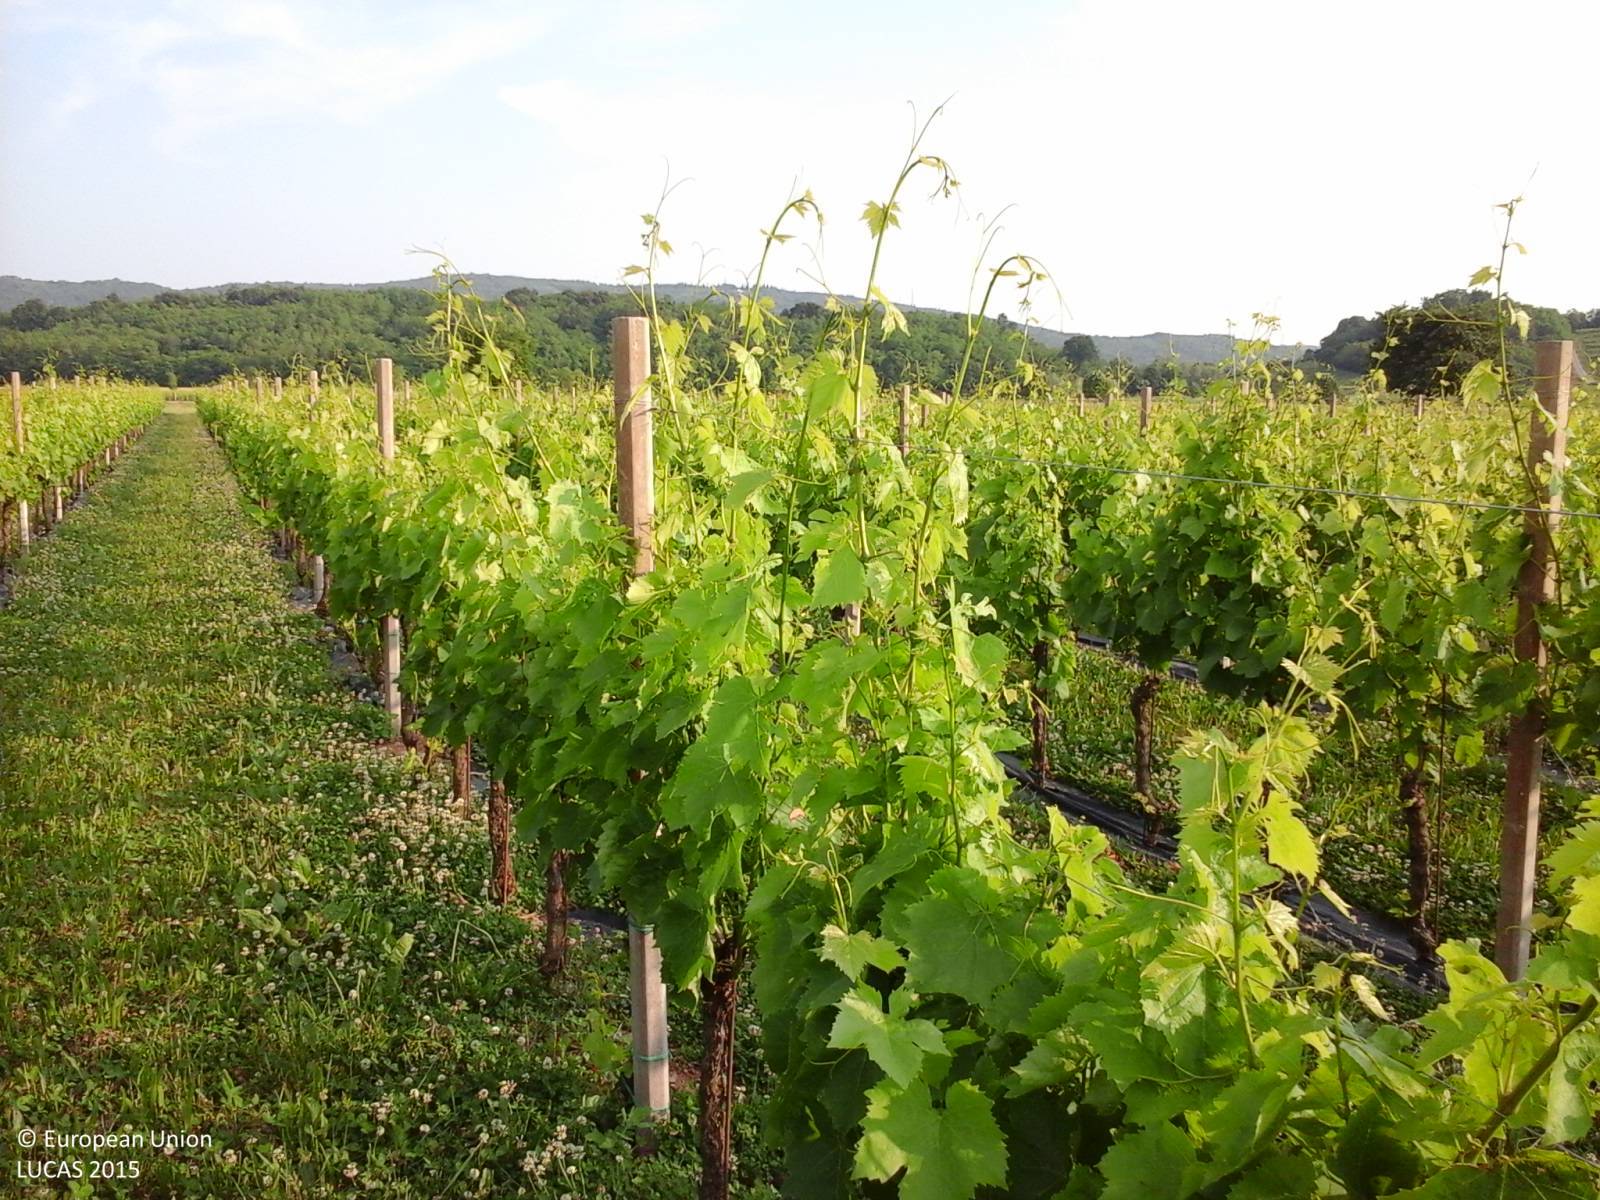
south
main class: Cropland
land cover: Vineyards
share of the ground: > 75 %
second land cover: Grassland without tree/shrub cover
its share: > 75 %
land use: Agriculture (excluding fallow land and kitchen gardens)
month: June
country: IT
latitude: 45.9139
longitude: 13.5415
